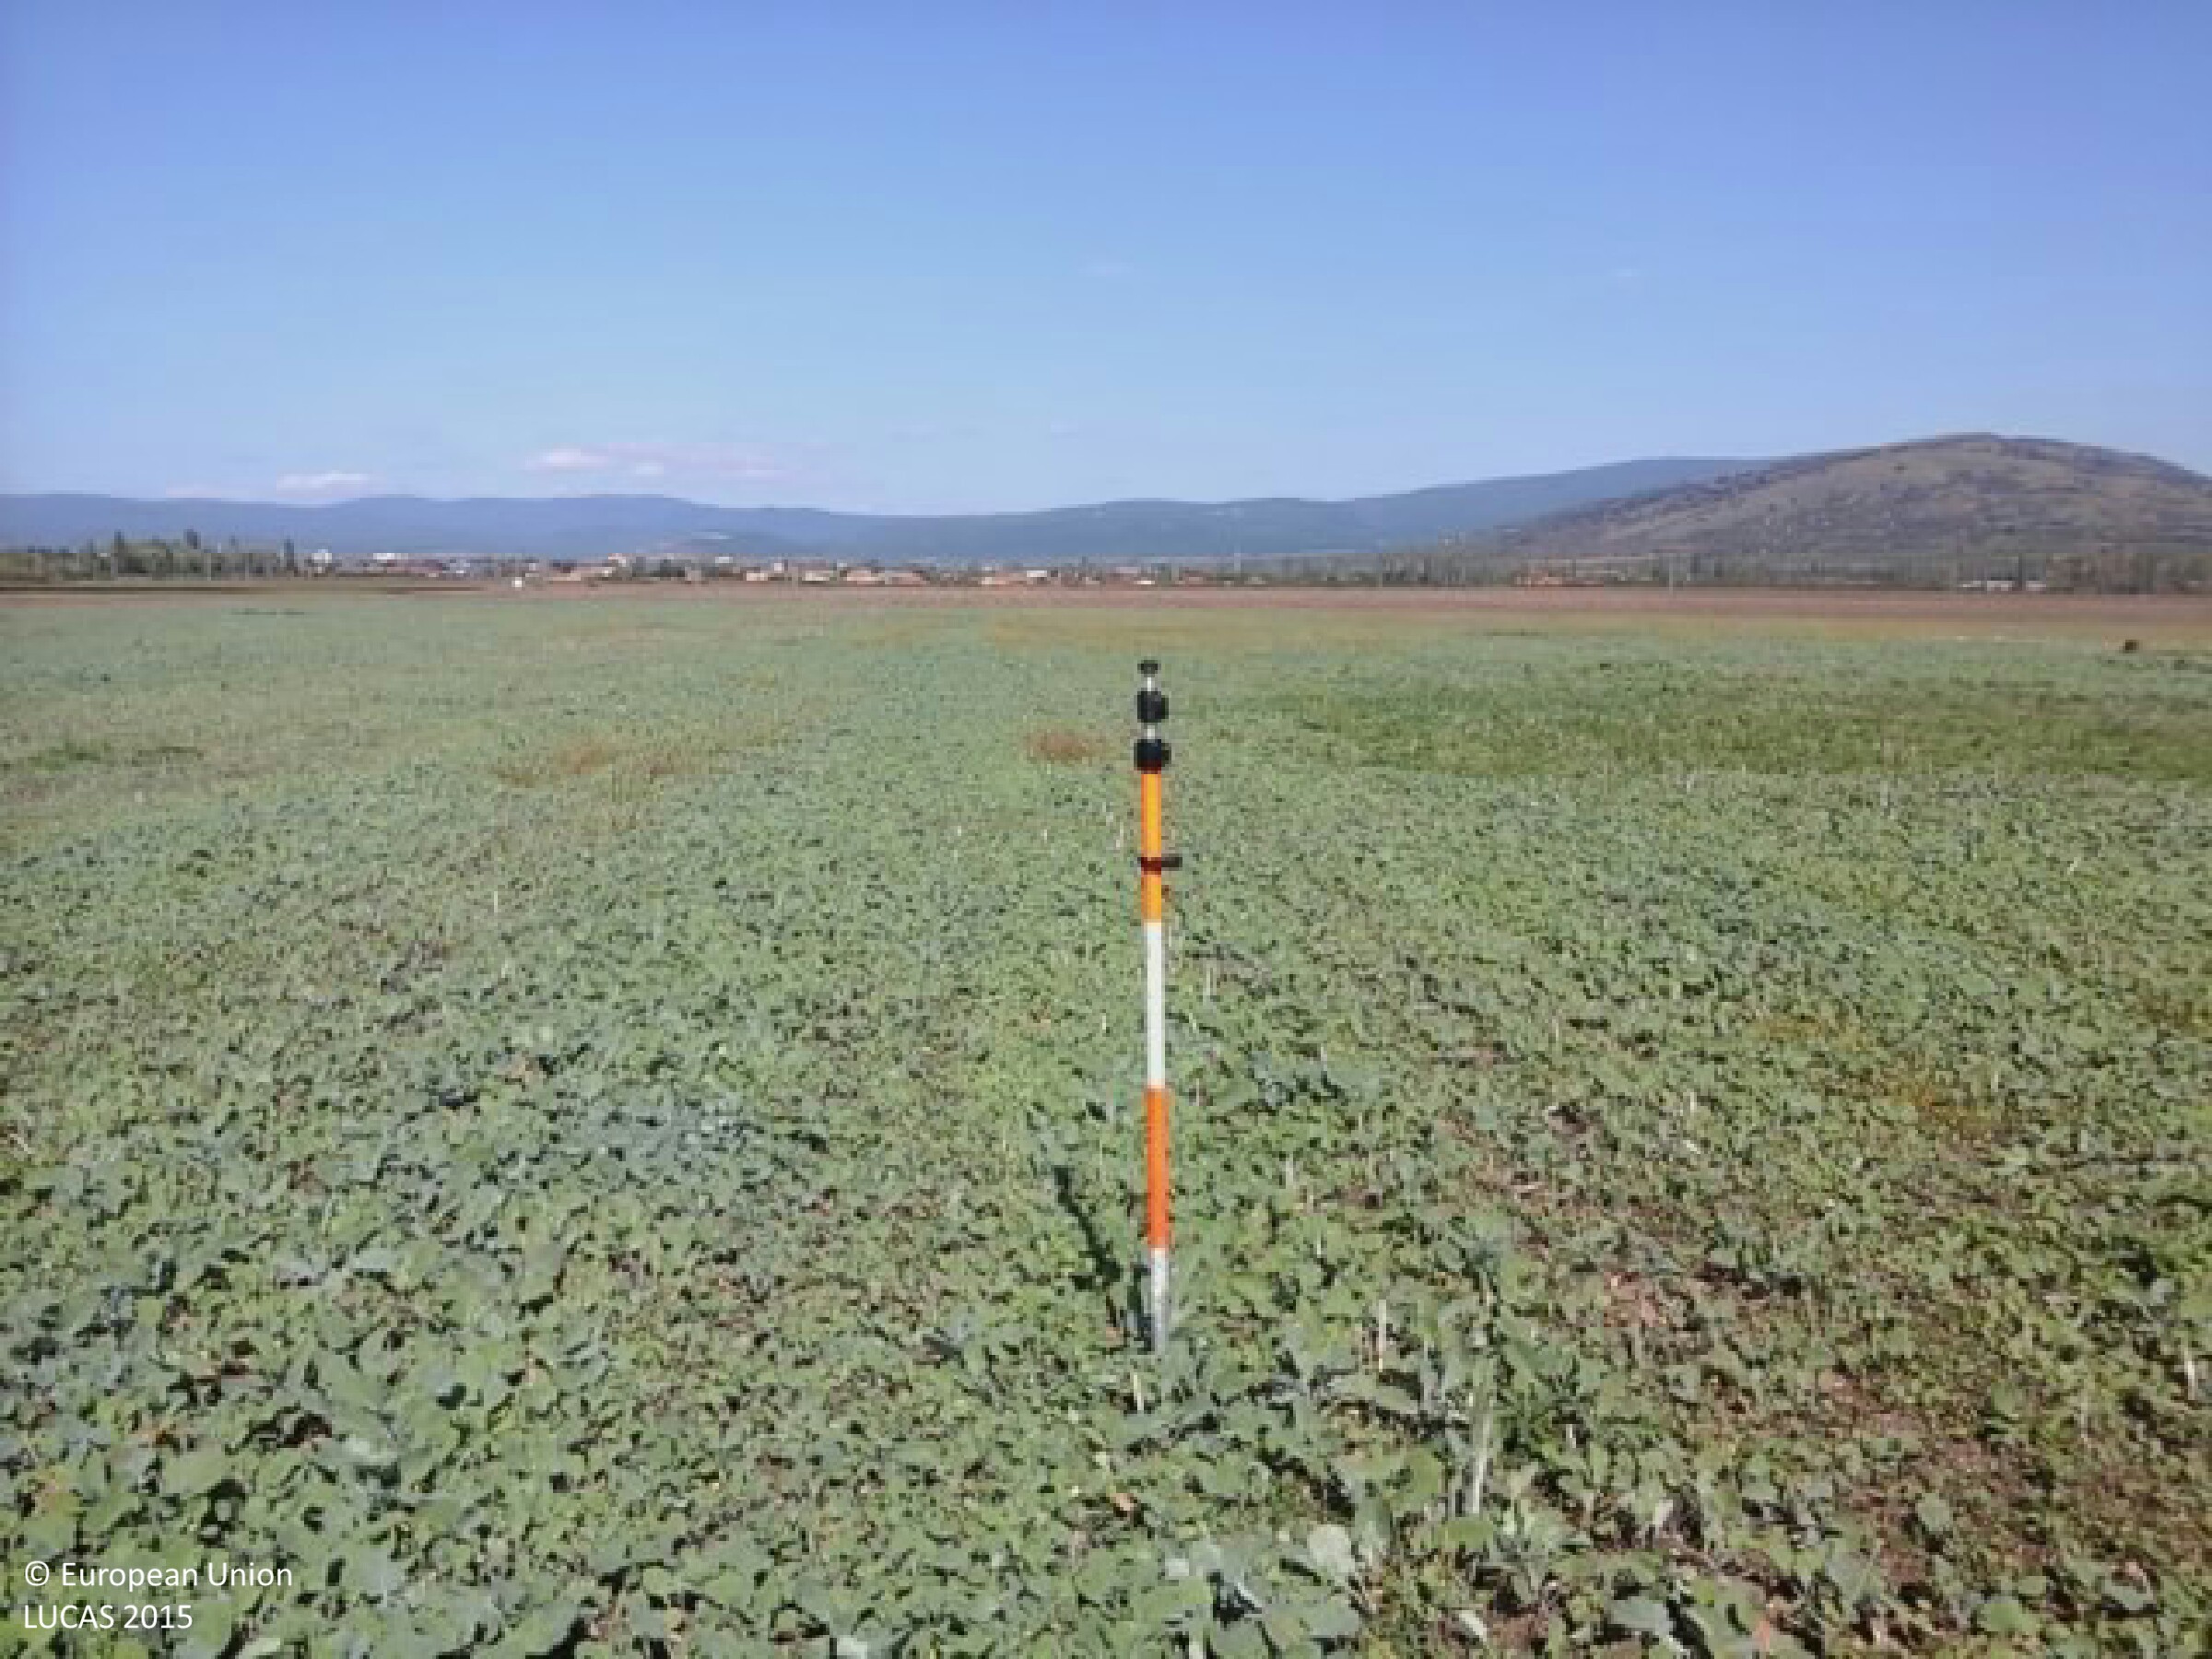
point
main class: Cropland
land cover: Rape and turnip rape
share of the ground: > 75 %
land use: Agriculture (excluding fallow land and kitchen gardens)
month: September
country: HU
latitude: 47.7553
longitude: 19.9379
